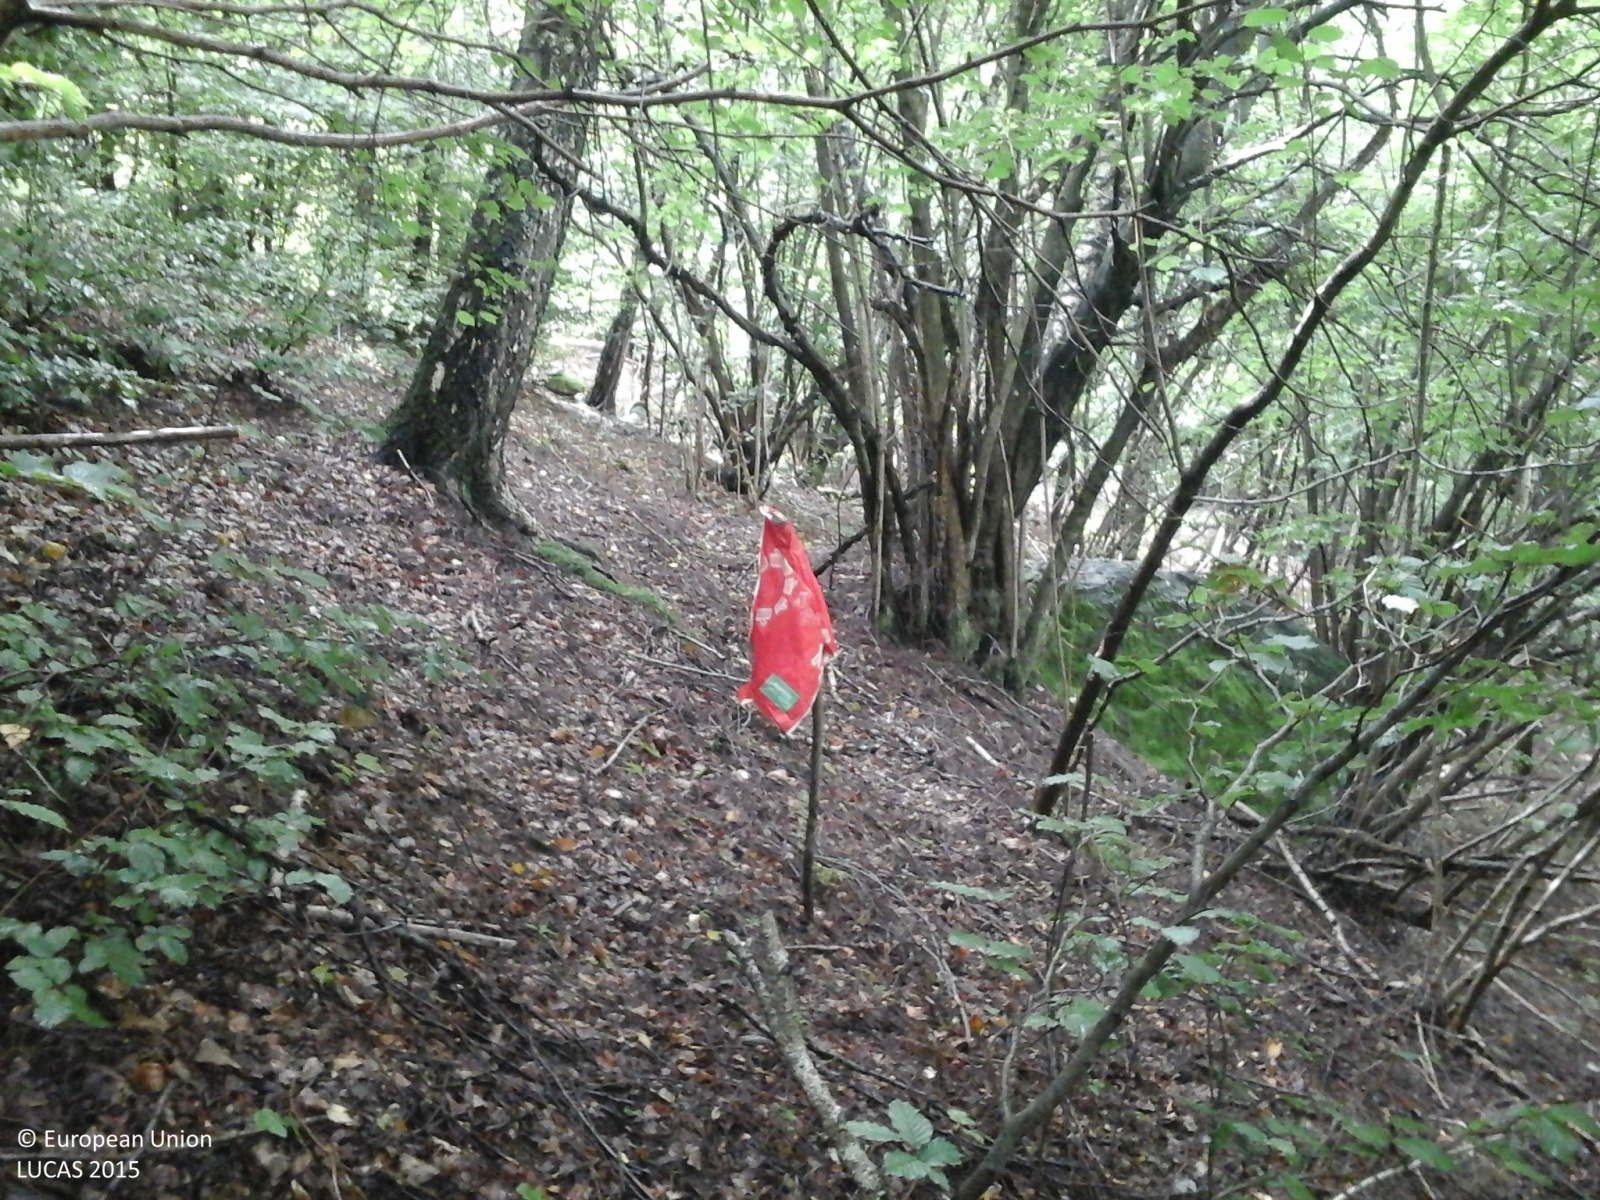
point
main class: Woodland
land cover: Broadleaved woodland
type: mountainous beech forest
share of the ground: > 75 %
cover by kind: broadleaved forest trees 75 %, herbaceous plants 20 %, consolidated bare surface 5 %
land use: Forestry
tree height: > 5 m
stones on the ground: 10 - 25 %
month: August
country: IT
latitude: 45.9151
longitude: 9.1117
